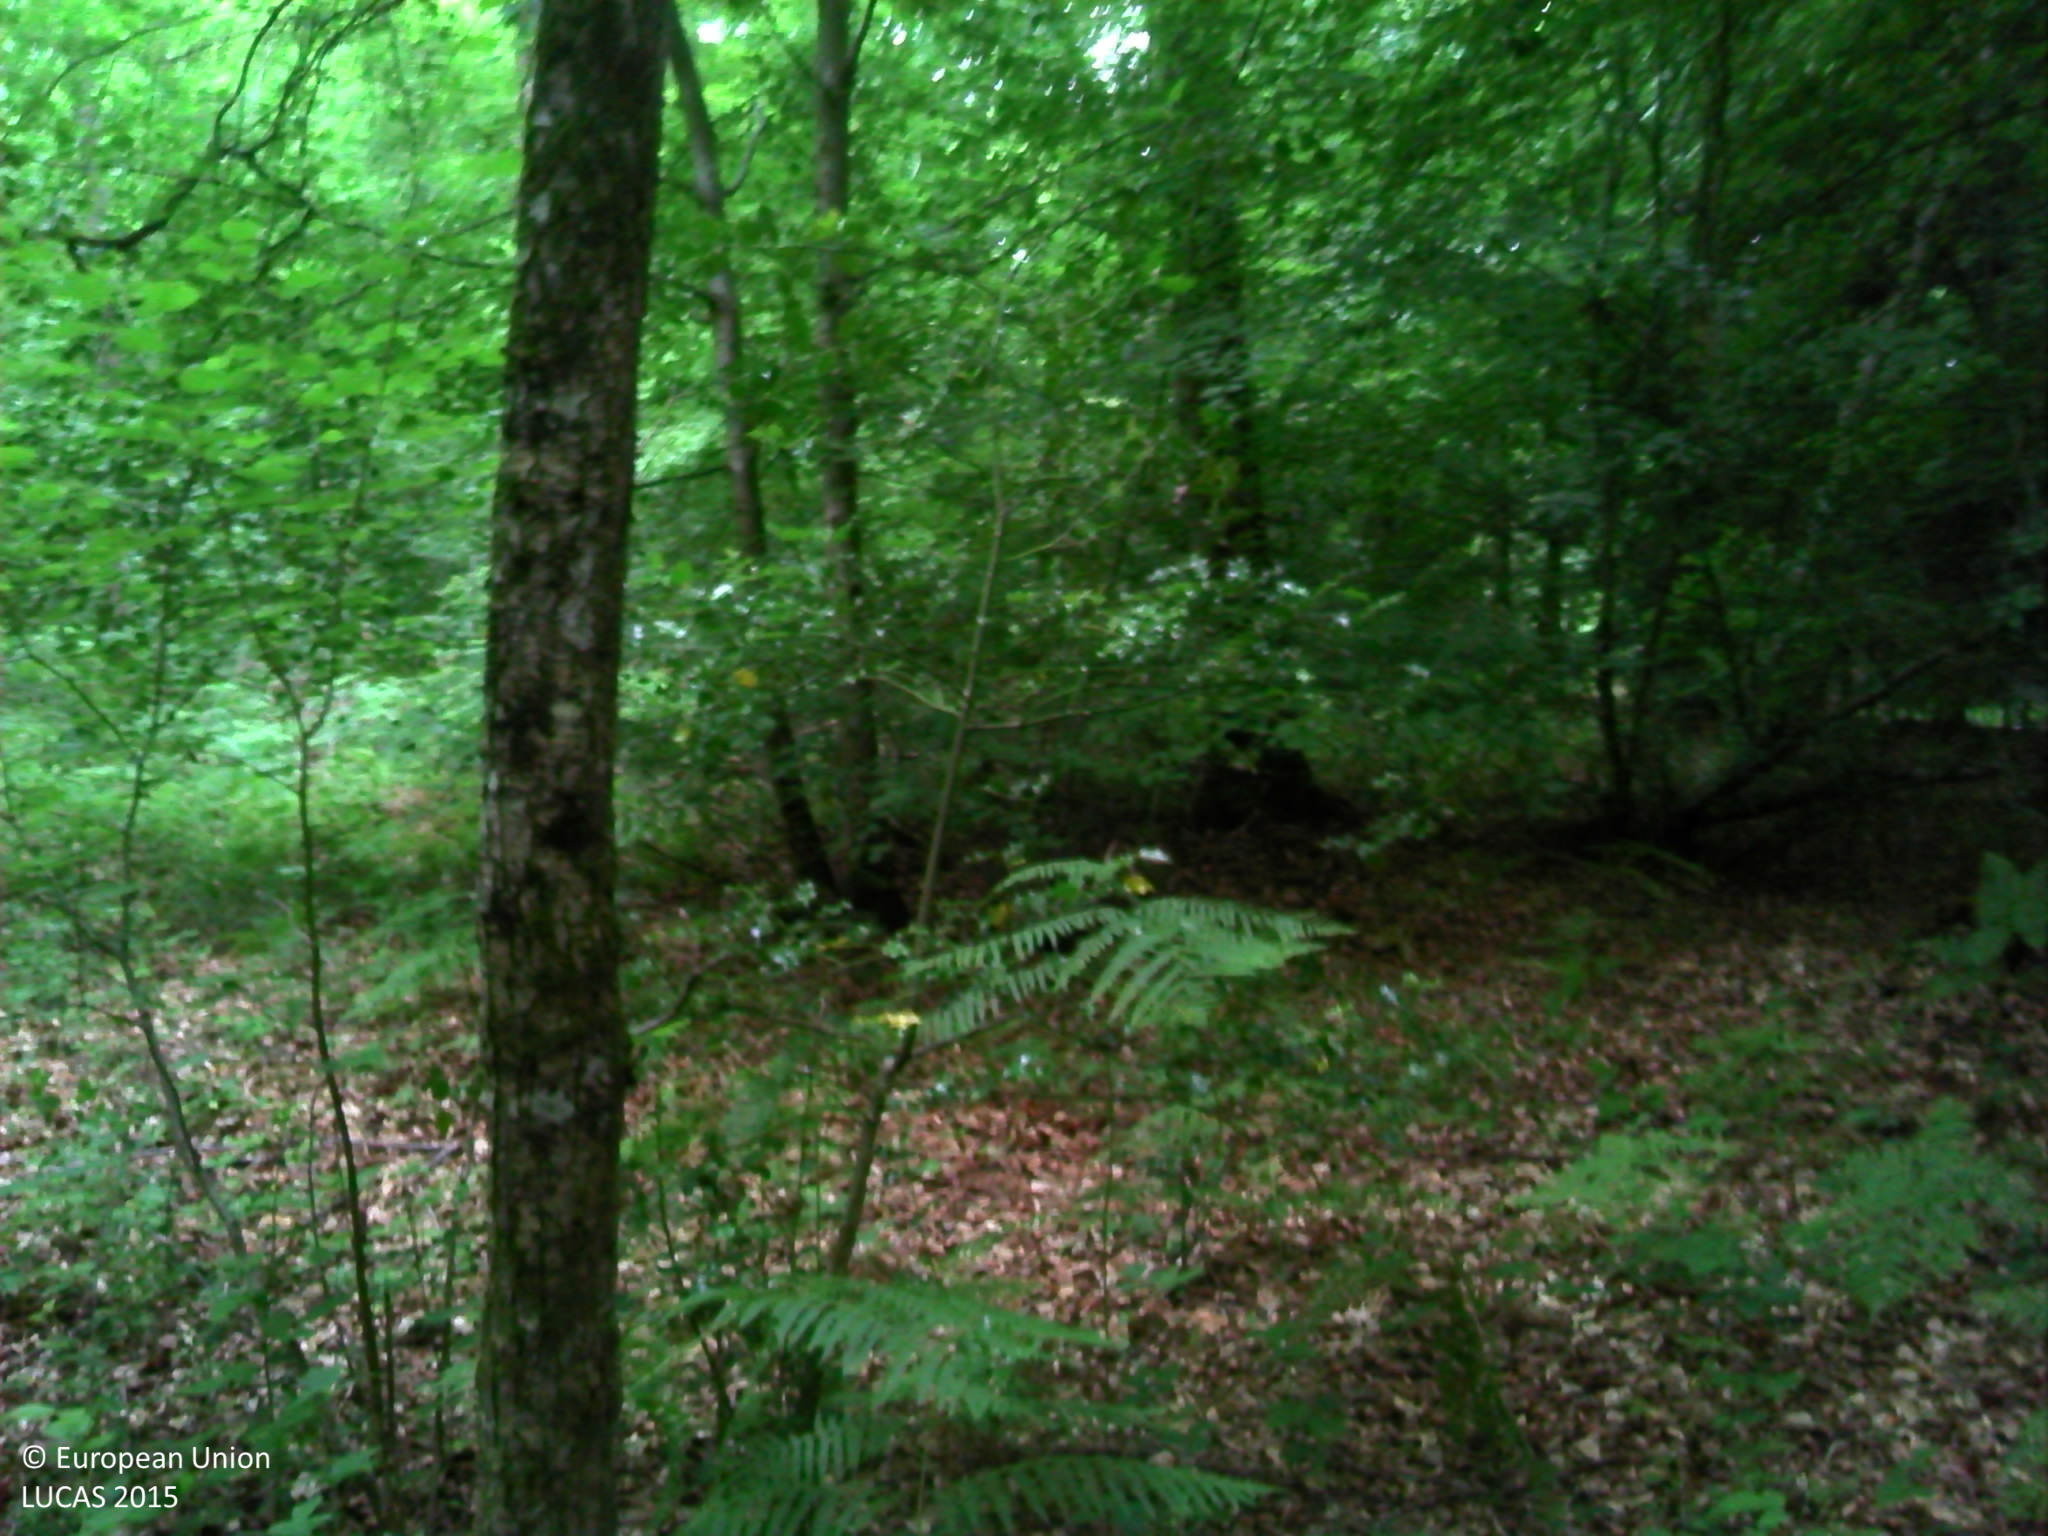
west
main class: Woodland
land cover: Broadleaved woodland
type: acidophilous oak and oak-birch forest
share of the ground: > 75 %
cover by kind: broadleaved forest trees 75 %, coniferous forest trees 10 %, herbaceous plants 10 %, shrubs 5 %
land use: Forestry
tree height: > 5 m
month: July
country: FR
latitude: 48.9345
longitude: 0.0732
